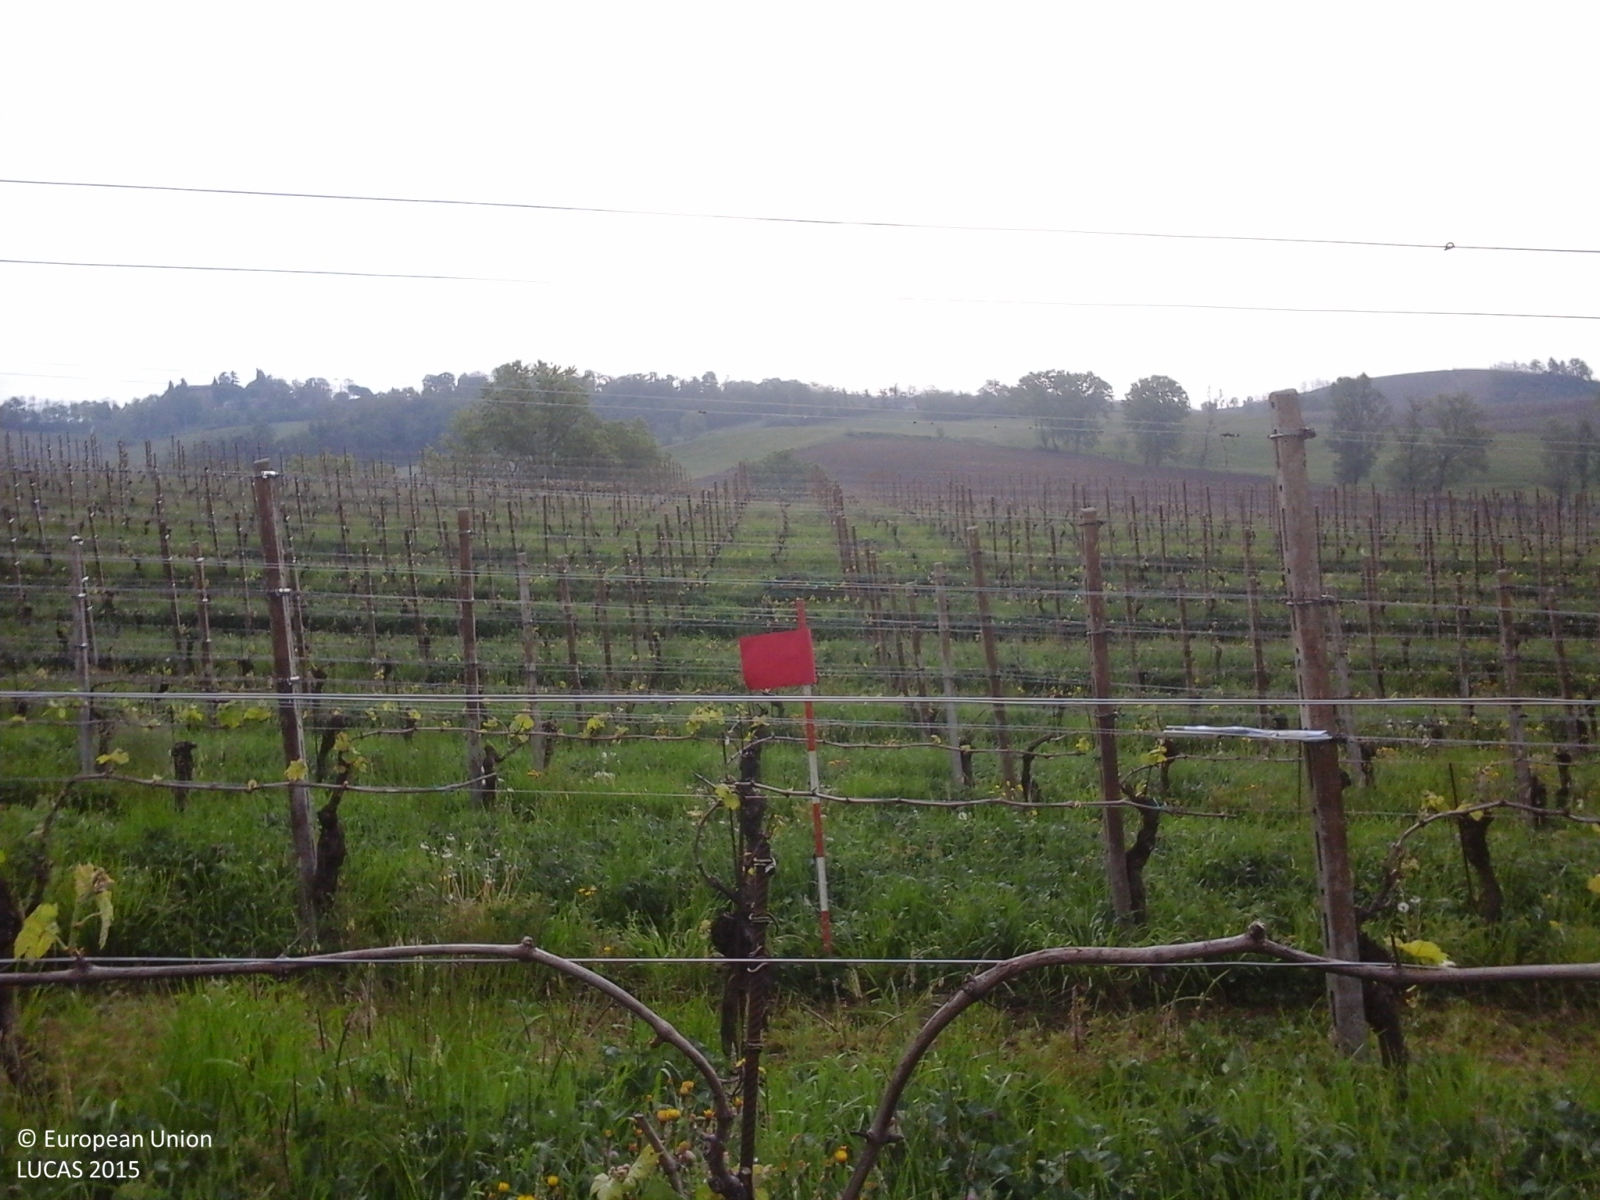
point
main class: Cropland
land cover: Vineyards
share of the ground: < 10 %
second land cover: Grassland without tree/shrub cover
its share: > 75 %
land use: Agriculture (excluding fallow land and kitchen gardens)
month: April
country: IT
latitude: 44.9618
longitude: 9.3800
